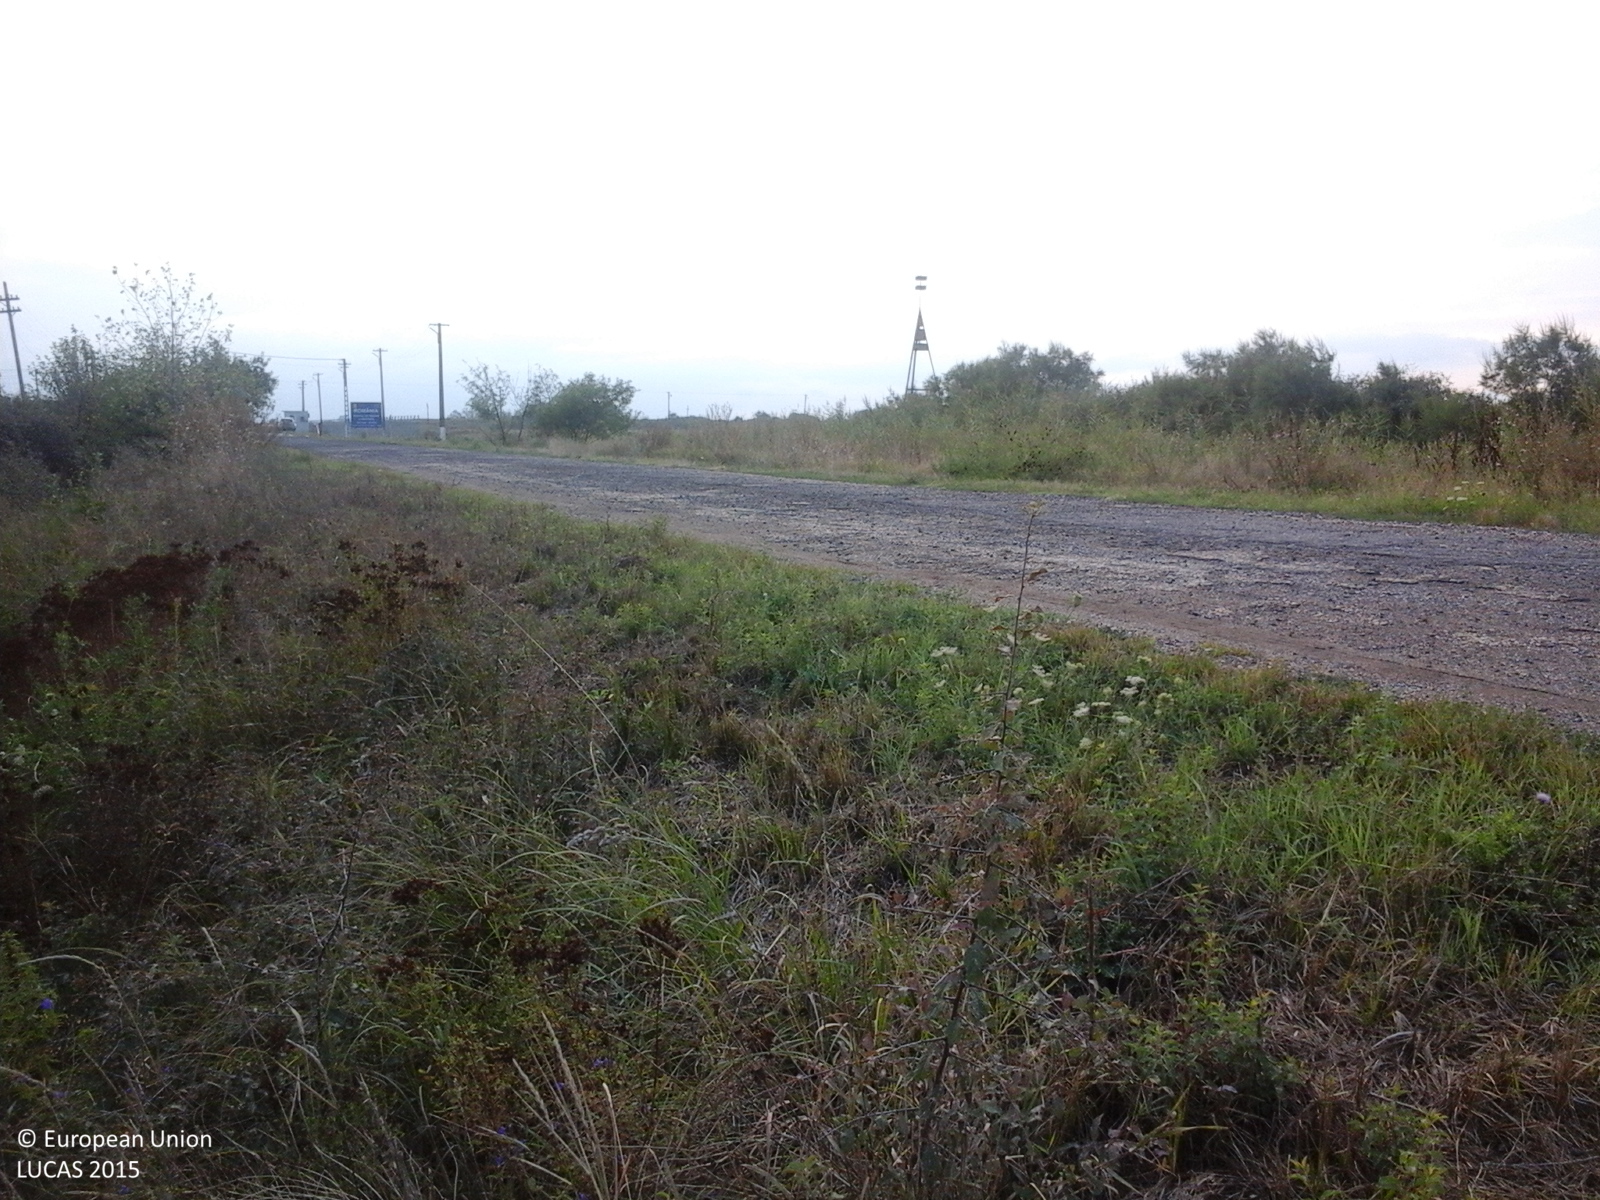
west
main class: Cropland
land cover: Sunflower
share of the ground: > 75 %
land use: Agriculture (excluding fallow land and kitchen gardens)
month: August
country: RO
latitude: 45.9916
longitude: 20.3640
